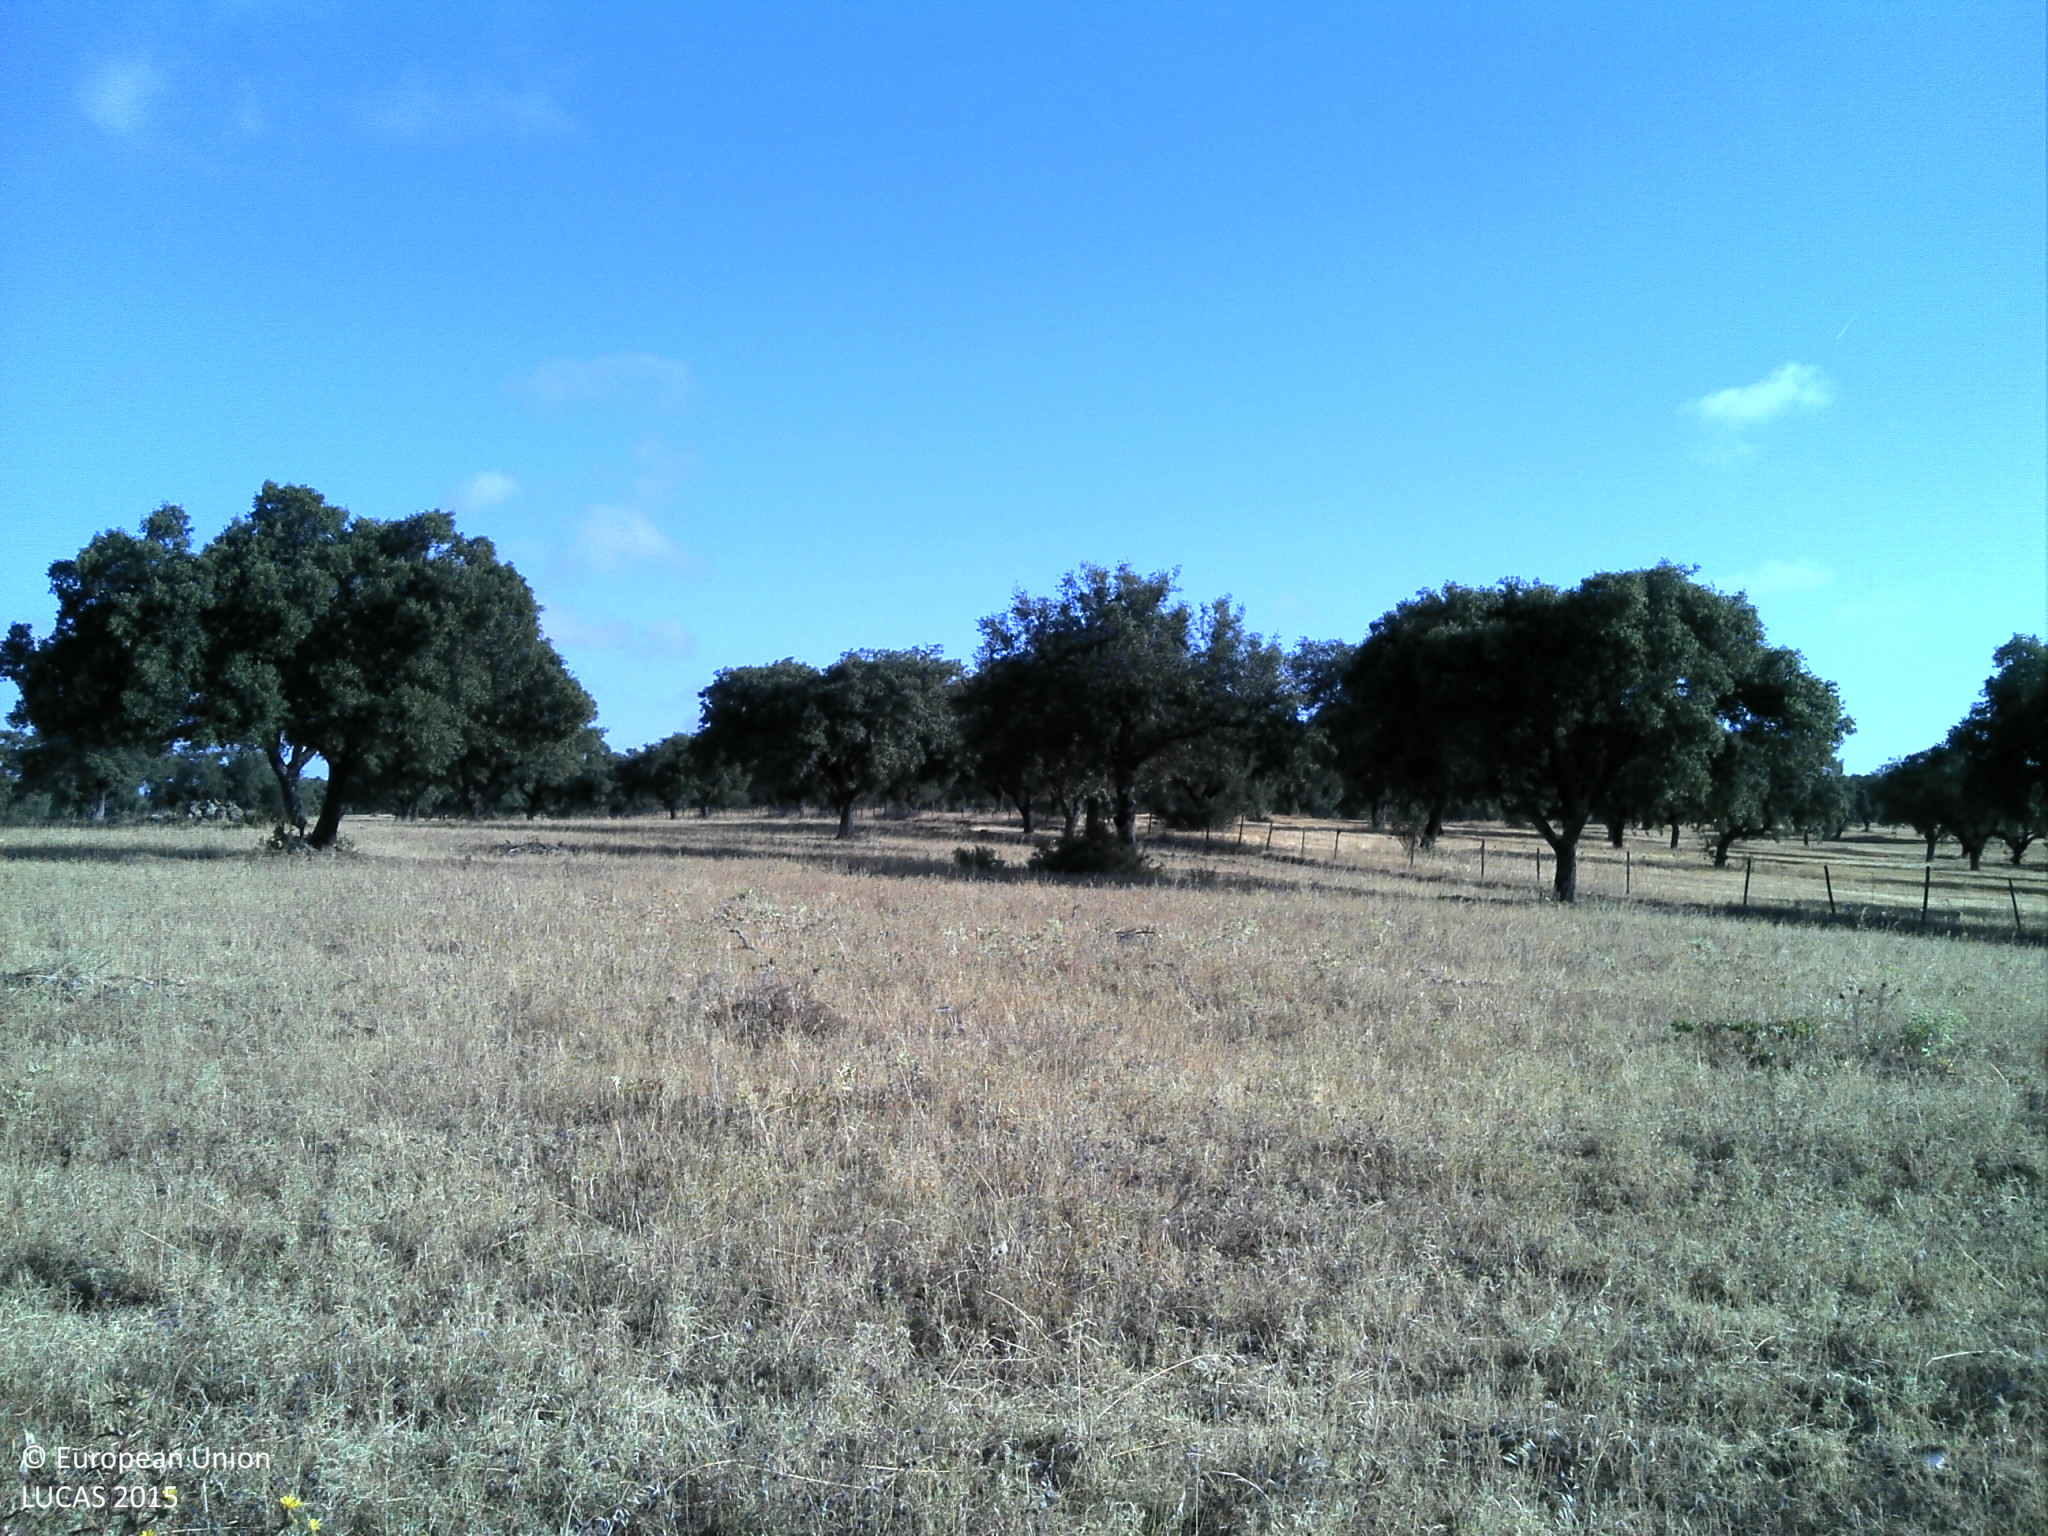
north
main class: Grassland
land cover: Grassland without tree/shrub cover
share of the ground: 10 - 25 %
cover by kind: unconsolidated bare surface 90 %, herbaceous plants 10 %
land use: Agriculture (excluding fallow land and kitchen gardens)
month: June
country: PT
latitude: 38.2478
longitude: -8.0332
